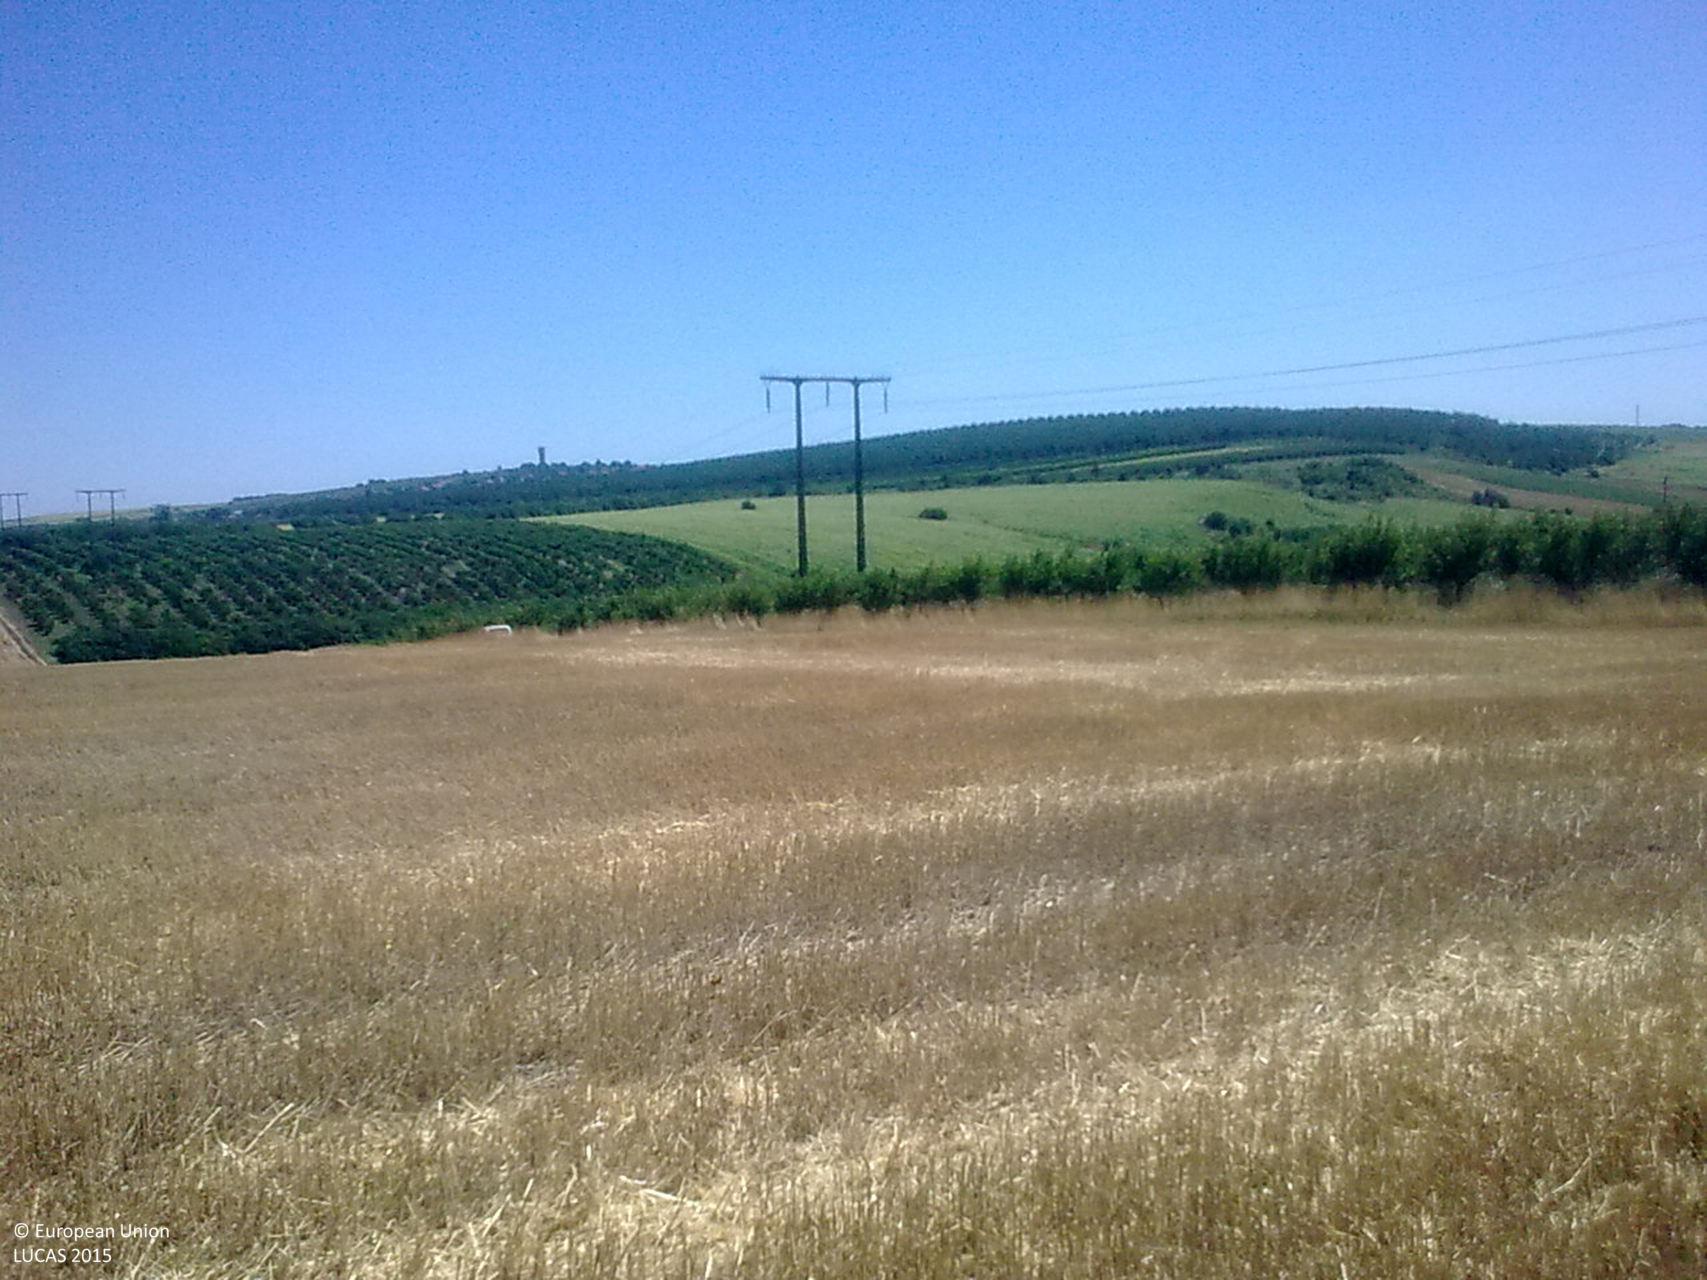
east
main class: Cropland
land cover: Common wheat
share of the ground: 50 - 75 %
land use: Agriculture (excluding fallow land and kitchen gardens)
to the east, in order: Common wheat; Grass margins; Tracks; Grass margins; Other fruit trees and berries; Grass margins; Tracks; Grass margins; Other fruit trees and berries; Electric lines; Other fruit trees and berries; Grass margins; Tracks; Grass margins; Other fruit trees and berries
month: July
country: BG
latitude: 43.9001
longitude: 26.2762
